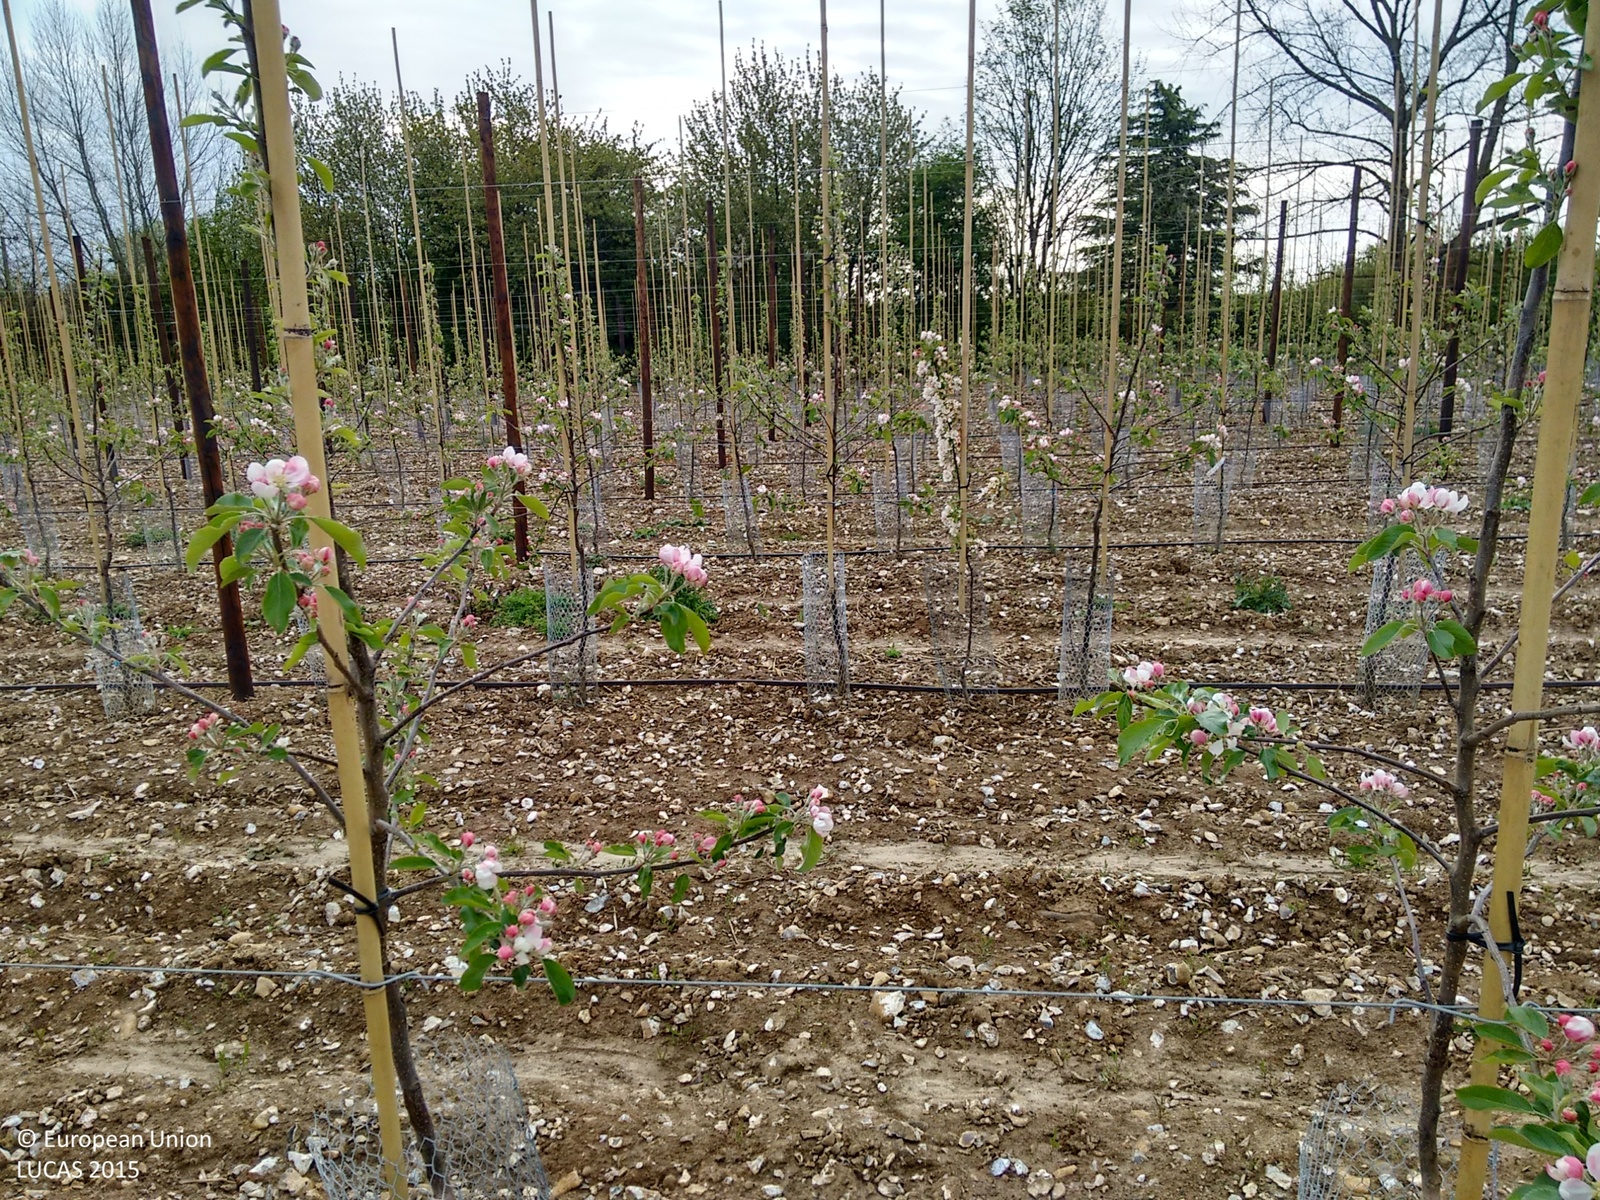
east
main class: Cropland
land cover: Apple fruit
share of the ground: 10 - 25 %
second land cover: Other bare soil
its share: > 75 %
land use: Agriculture (excluding fallow land and kitchen gardens)
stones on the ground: 25 - 50 %
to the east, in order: Apple fruit; Other bare soil; Managed hedges; Fences; Grass margins; Paved roads, cycling and walking lanes; Grass margins; Managed hedges; Grassland without tree/shrub cover; Single bushes/trees; Tracks; Single bushes/trees; Artificial constructions in urban areas
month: May
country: GB
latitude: 51.2897
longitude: 0.7253
